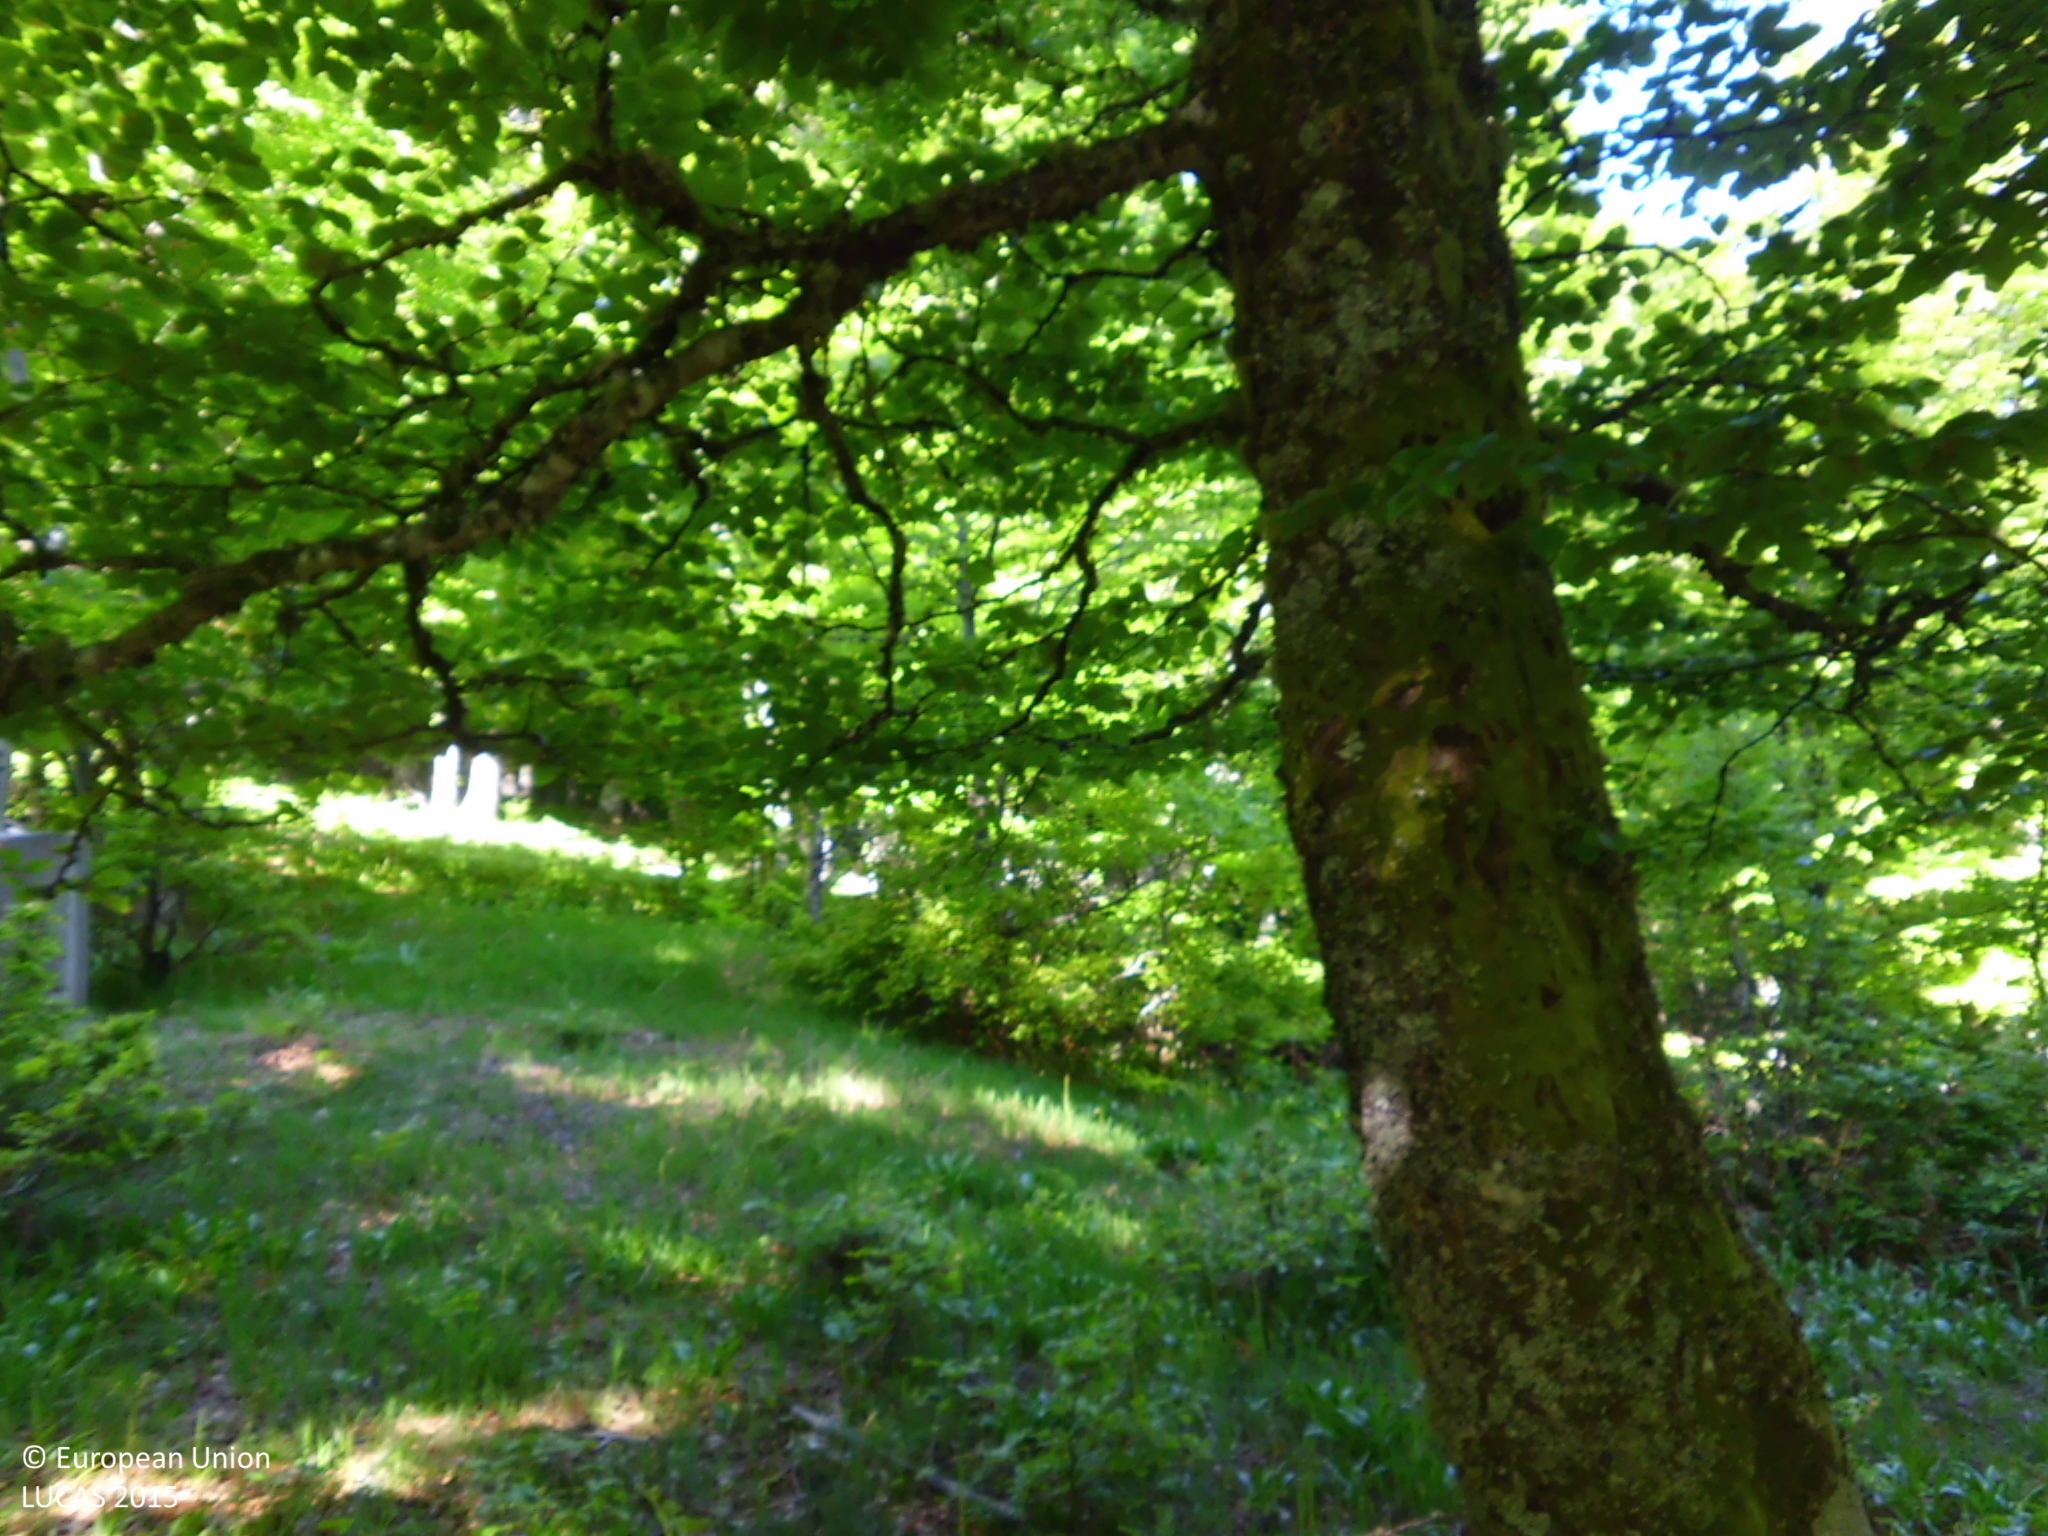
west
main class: Woodland
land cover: Broadleaved woodland
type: mountainous beech forest
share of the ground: 50 - 75 %
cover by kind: broadleaved forest trees 70 %, herbaceous plants 25 %, shrubs 5 %
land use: Semi-natural and natural areas not in use
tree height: > 5 m
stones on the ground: > 50 %
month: May
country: ES
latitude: 43.1032
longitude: -5.0210
